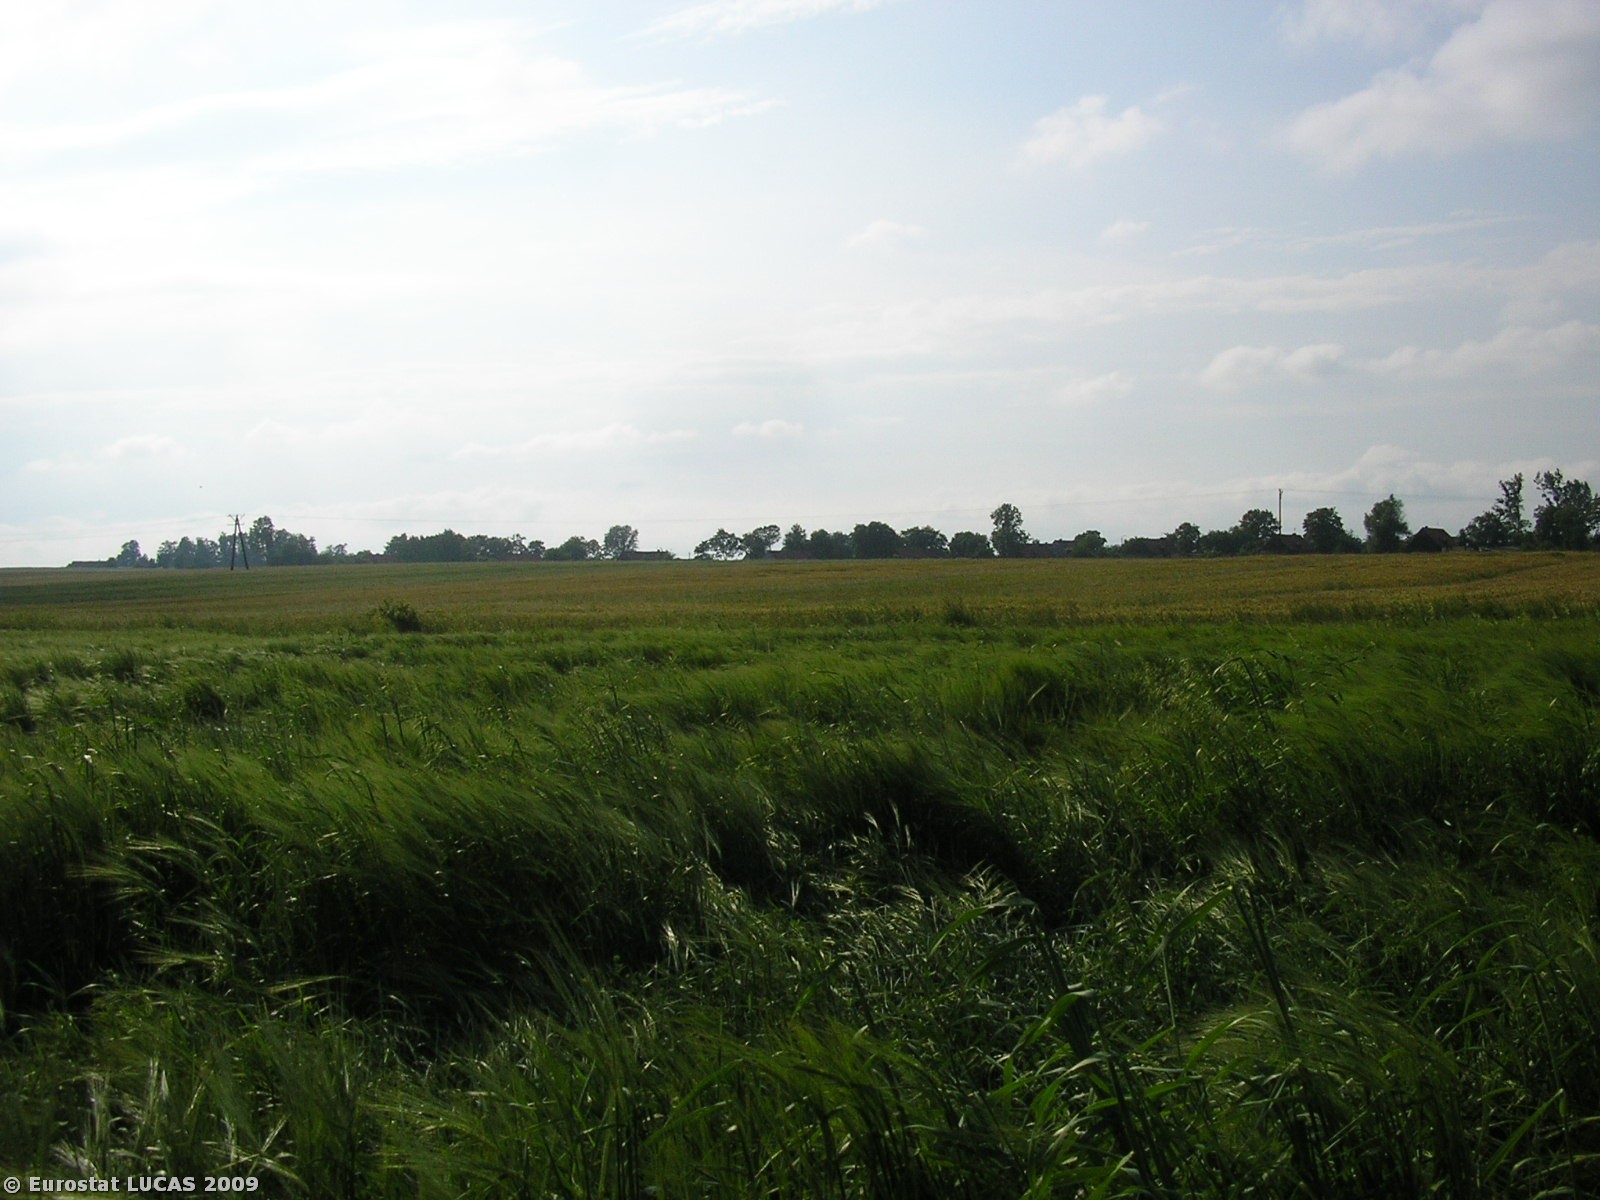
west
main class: Cropland
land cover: Barley
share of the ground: > 75 %
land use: Agriculture (excluding fallow land and kitchen gardens)
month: June
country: PL
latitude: 51.0853
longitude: 18.3986
